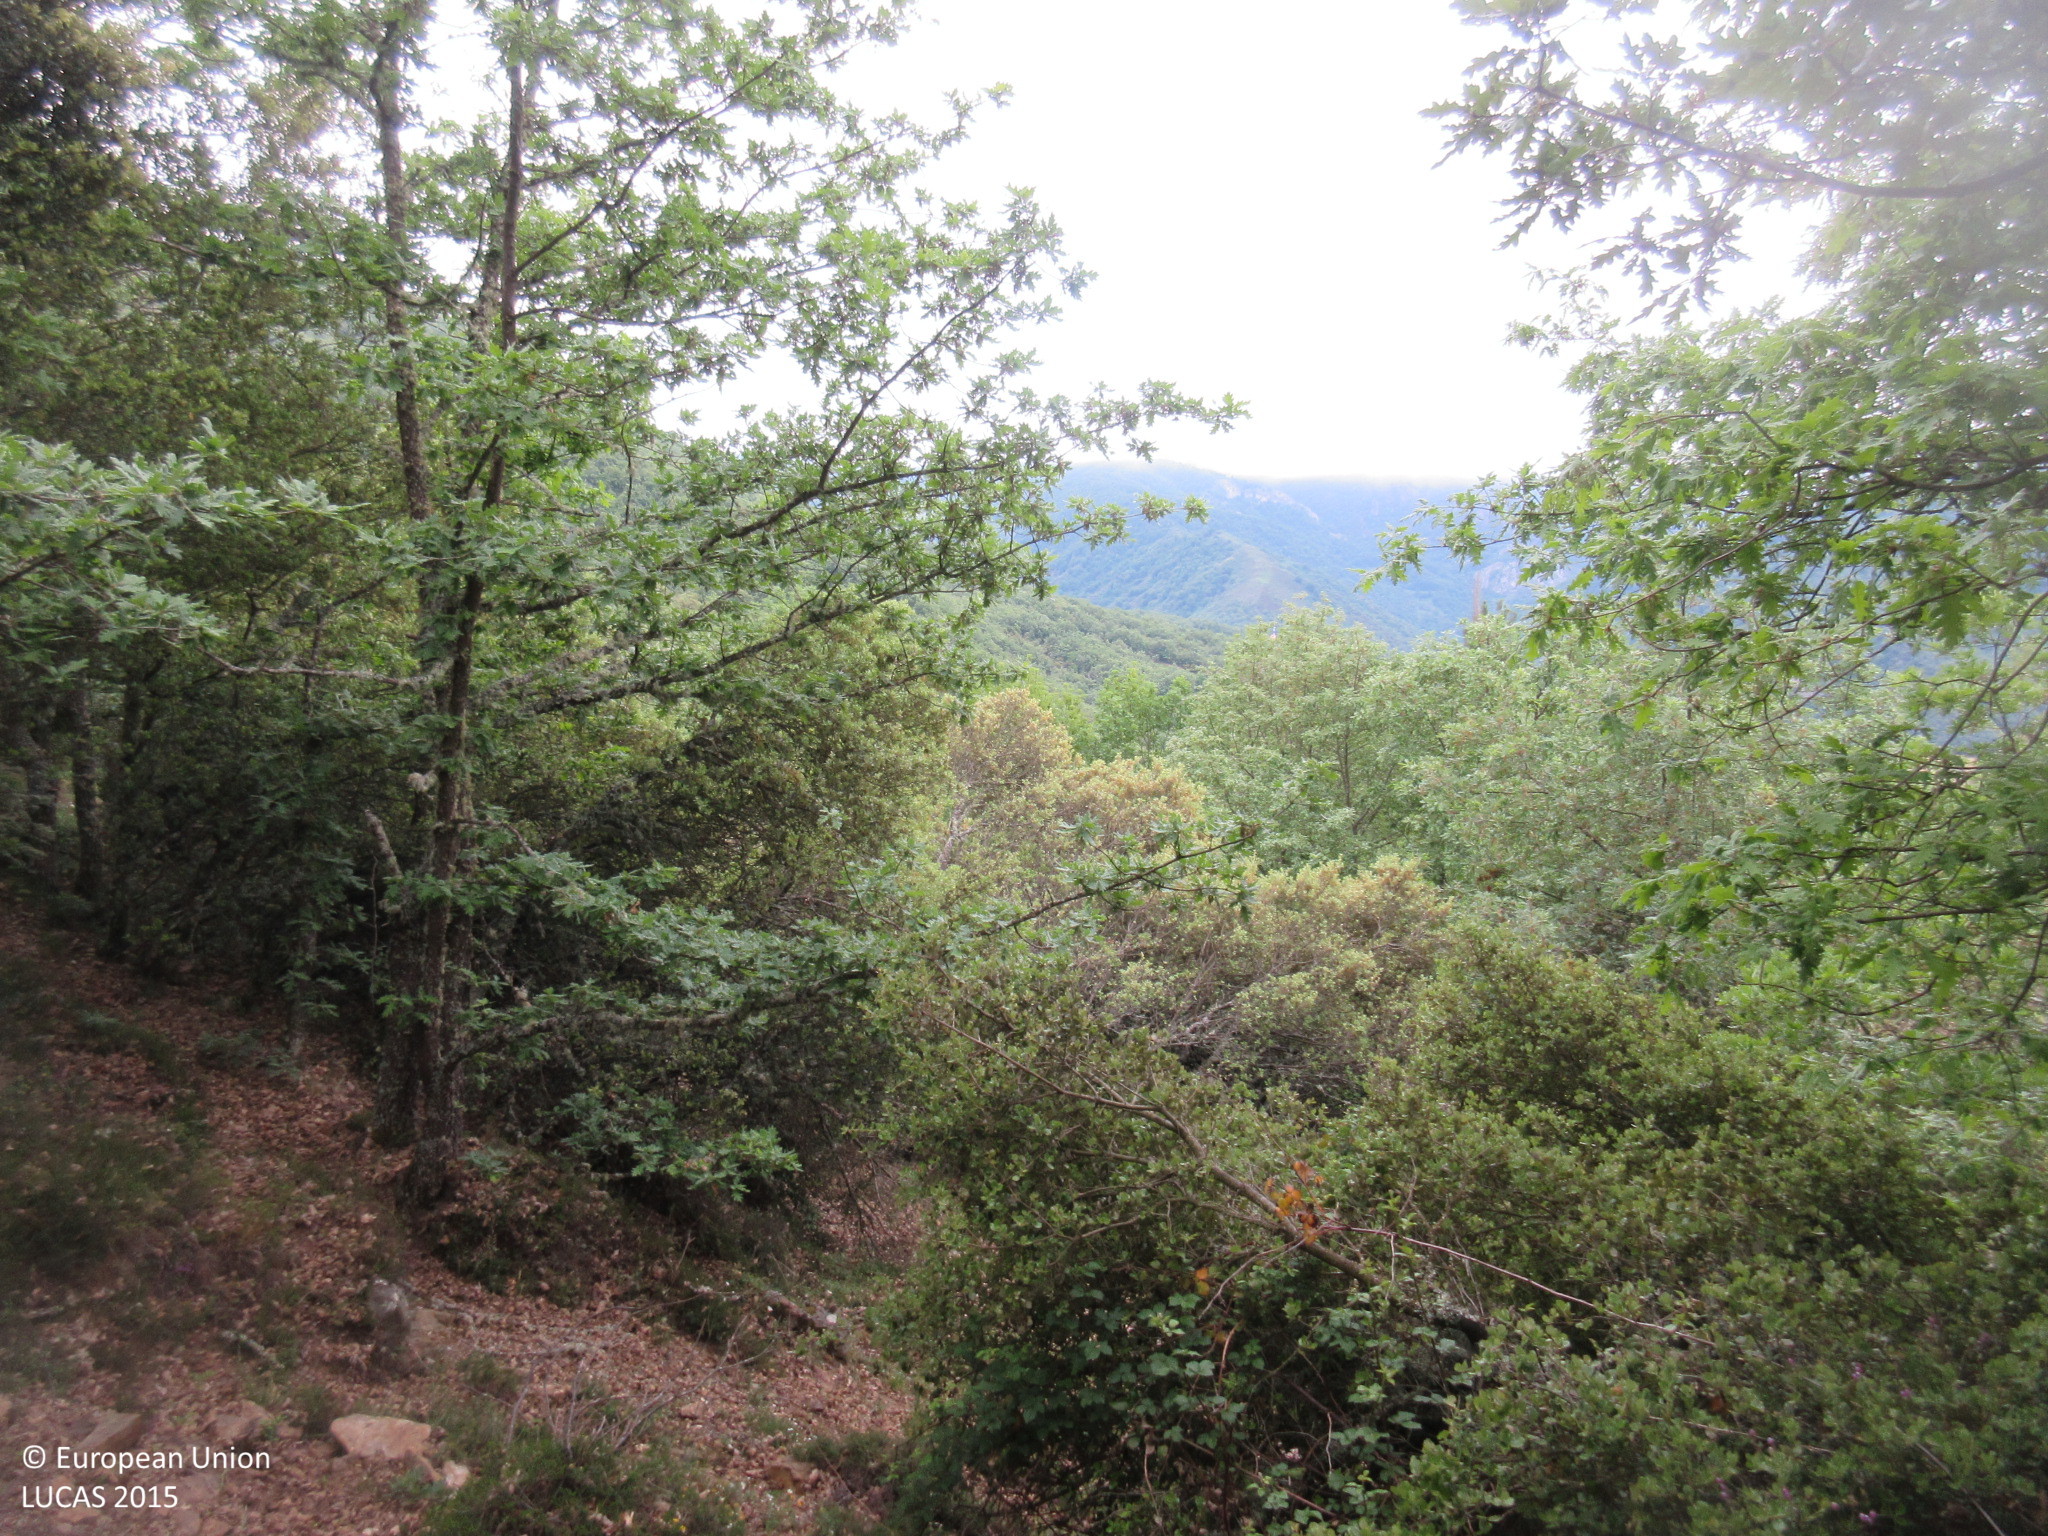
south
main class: Woodland
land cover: Broadleaved woodland
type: acidophilous oak and oak-birch forest
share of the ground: > 75 %
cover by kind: broadleaved forest trees 90 %, shrubs 10 %
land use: Forestry
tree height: > 5 m
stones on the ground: 10 - 25 %
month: June
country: ES
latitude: 43.0997
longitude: -4.5442
